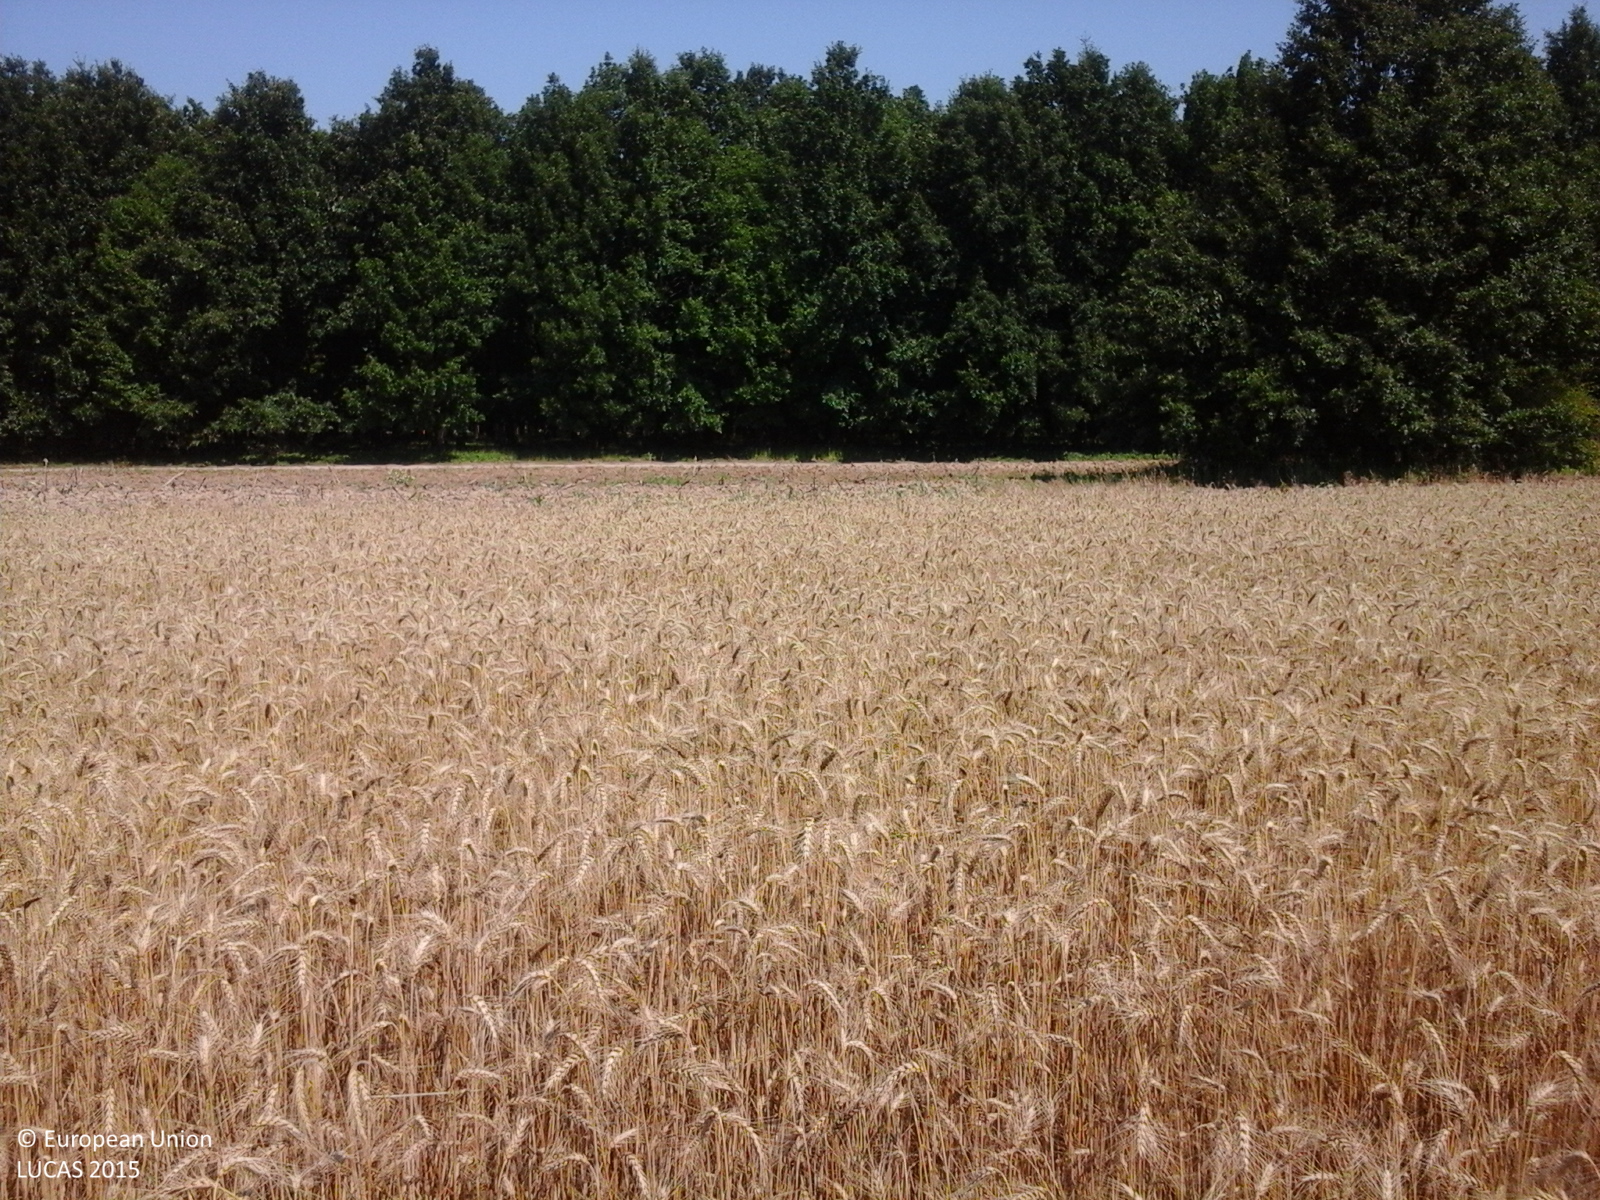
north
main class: Cropland
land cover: Common wheat
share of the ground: > 75 %
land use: Agriculture (excluding fallow land and kitchen gardens)
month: July
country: RO
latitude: 44.6845
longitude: 24.8540
